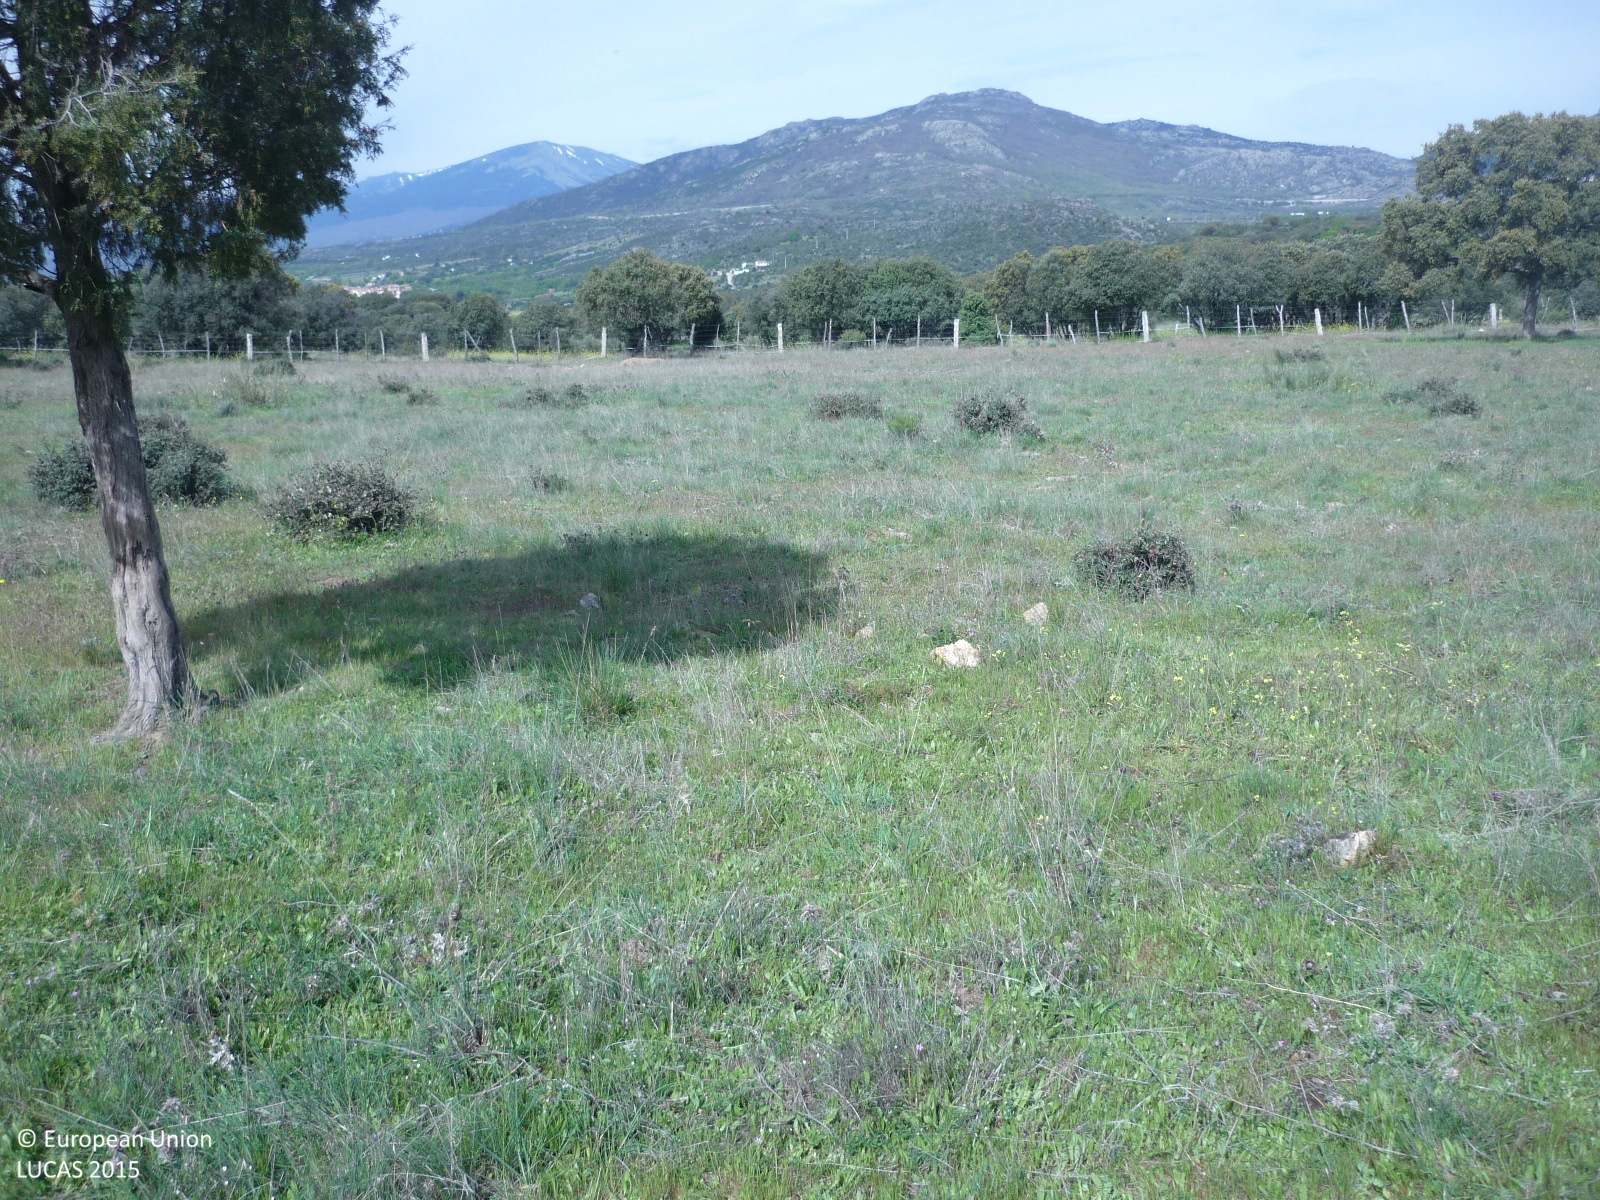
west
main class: Grassland
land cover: Grassland with sparse tree/shrub cover
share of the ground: > 75 %
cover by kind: herbaceous plants 85 %, shrubs 10 %, broadleaved forest trees 5 %
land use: Agriculture (excluding fallow land and kitchen gardens)
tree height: < 5 m
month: April
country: ES
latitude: 40.8294
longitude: -3.6431
